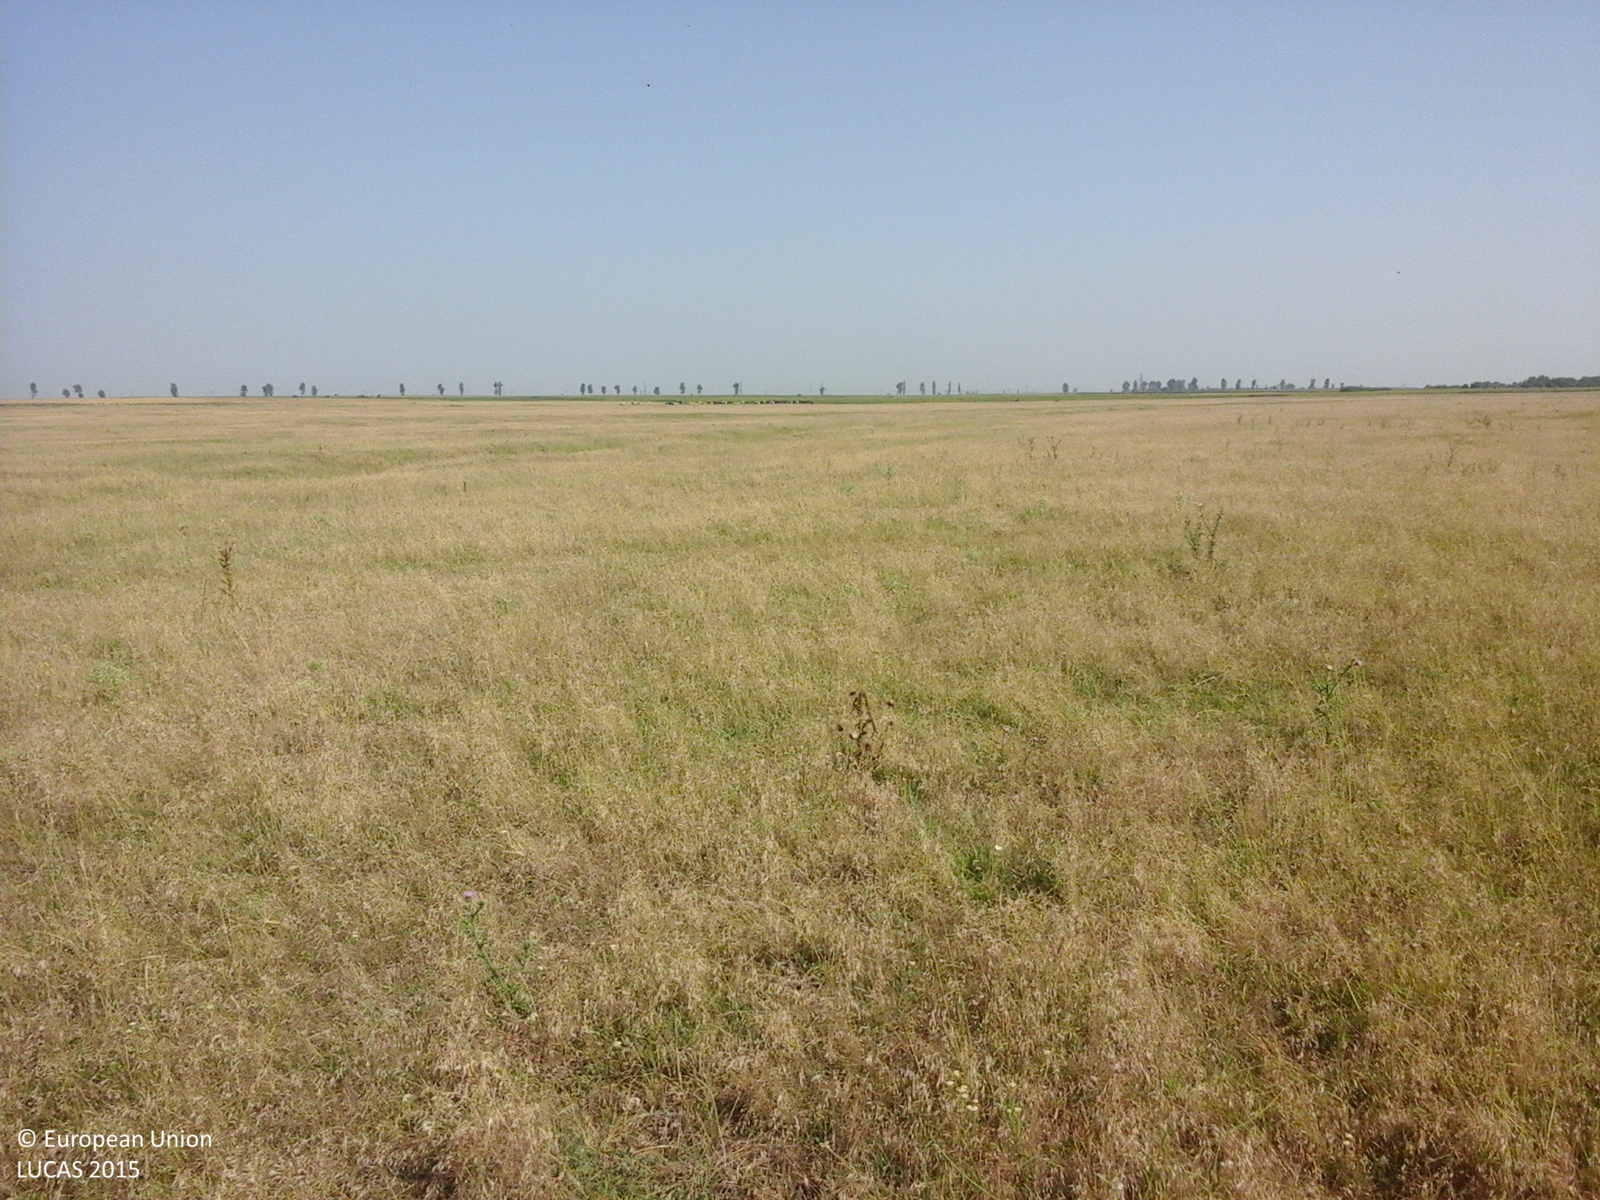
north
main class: Grassland
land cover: Grassland without tree/shrub cover
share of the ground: > 75 %
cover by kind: herbaceous plants 100 %
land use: Agriculture (excluding fallow land and kitchen gardens)
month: July
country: RO
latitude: 44.8129
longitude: 27.3256
